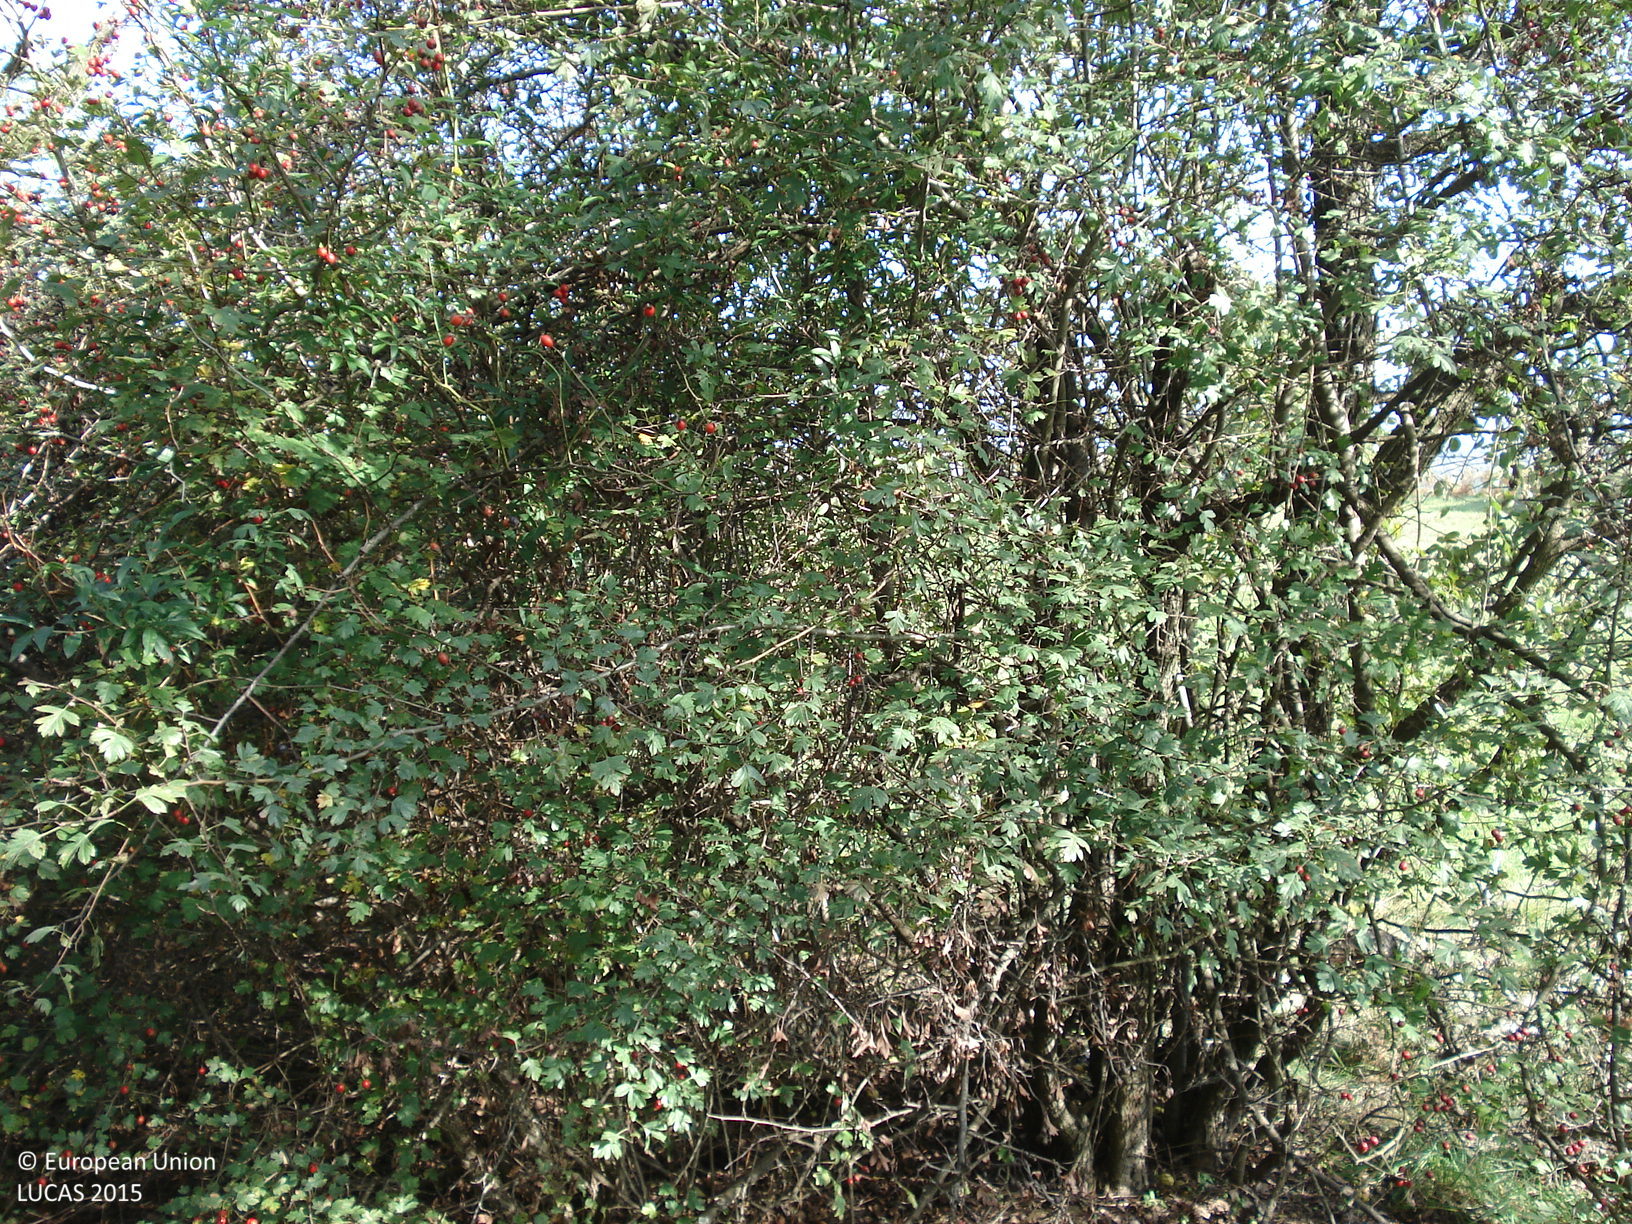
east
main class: Woodland
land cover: Broadleaved woodland
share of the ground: 50 - 75 %
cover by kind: broadleaved forest trees 60 %, herbaceous plants 25 %, shrubs 15 %
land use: Agriculture (excluding fallow land and kitchen gardens)
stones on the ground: < 10 %
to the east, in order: Broadleaved woodland; Shrubland with sparse tree cover; Tracks; Grassland without tree/shrub cover; Tracks; Electric lines; Grassland without tree/shrub cover; Broadleaved woodland; Grassland with sparse tree/shrub cover; Tracks; Grassland without tree/shrub cover
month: October
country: BG
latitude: 42.9220
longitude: 26.0755
